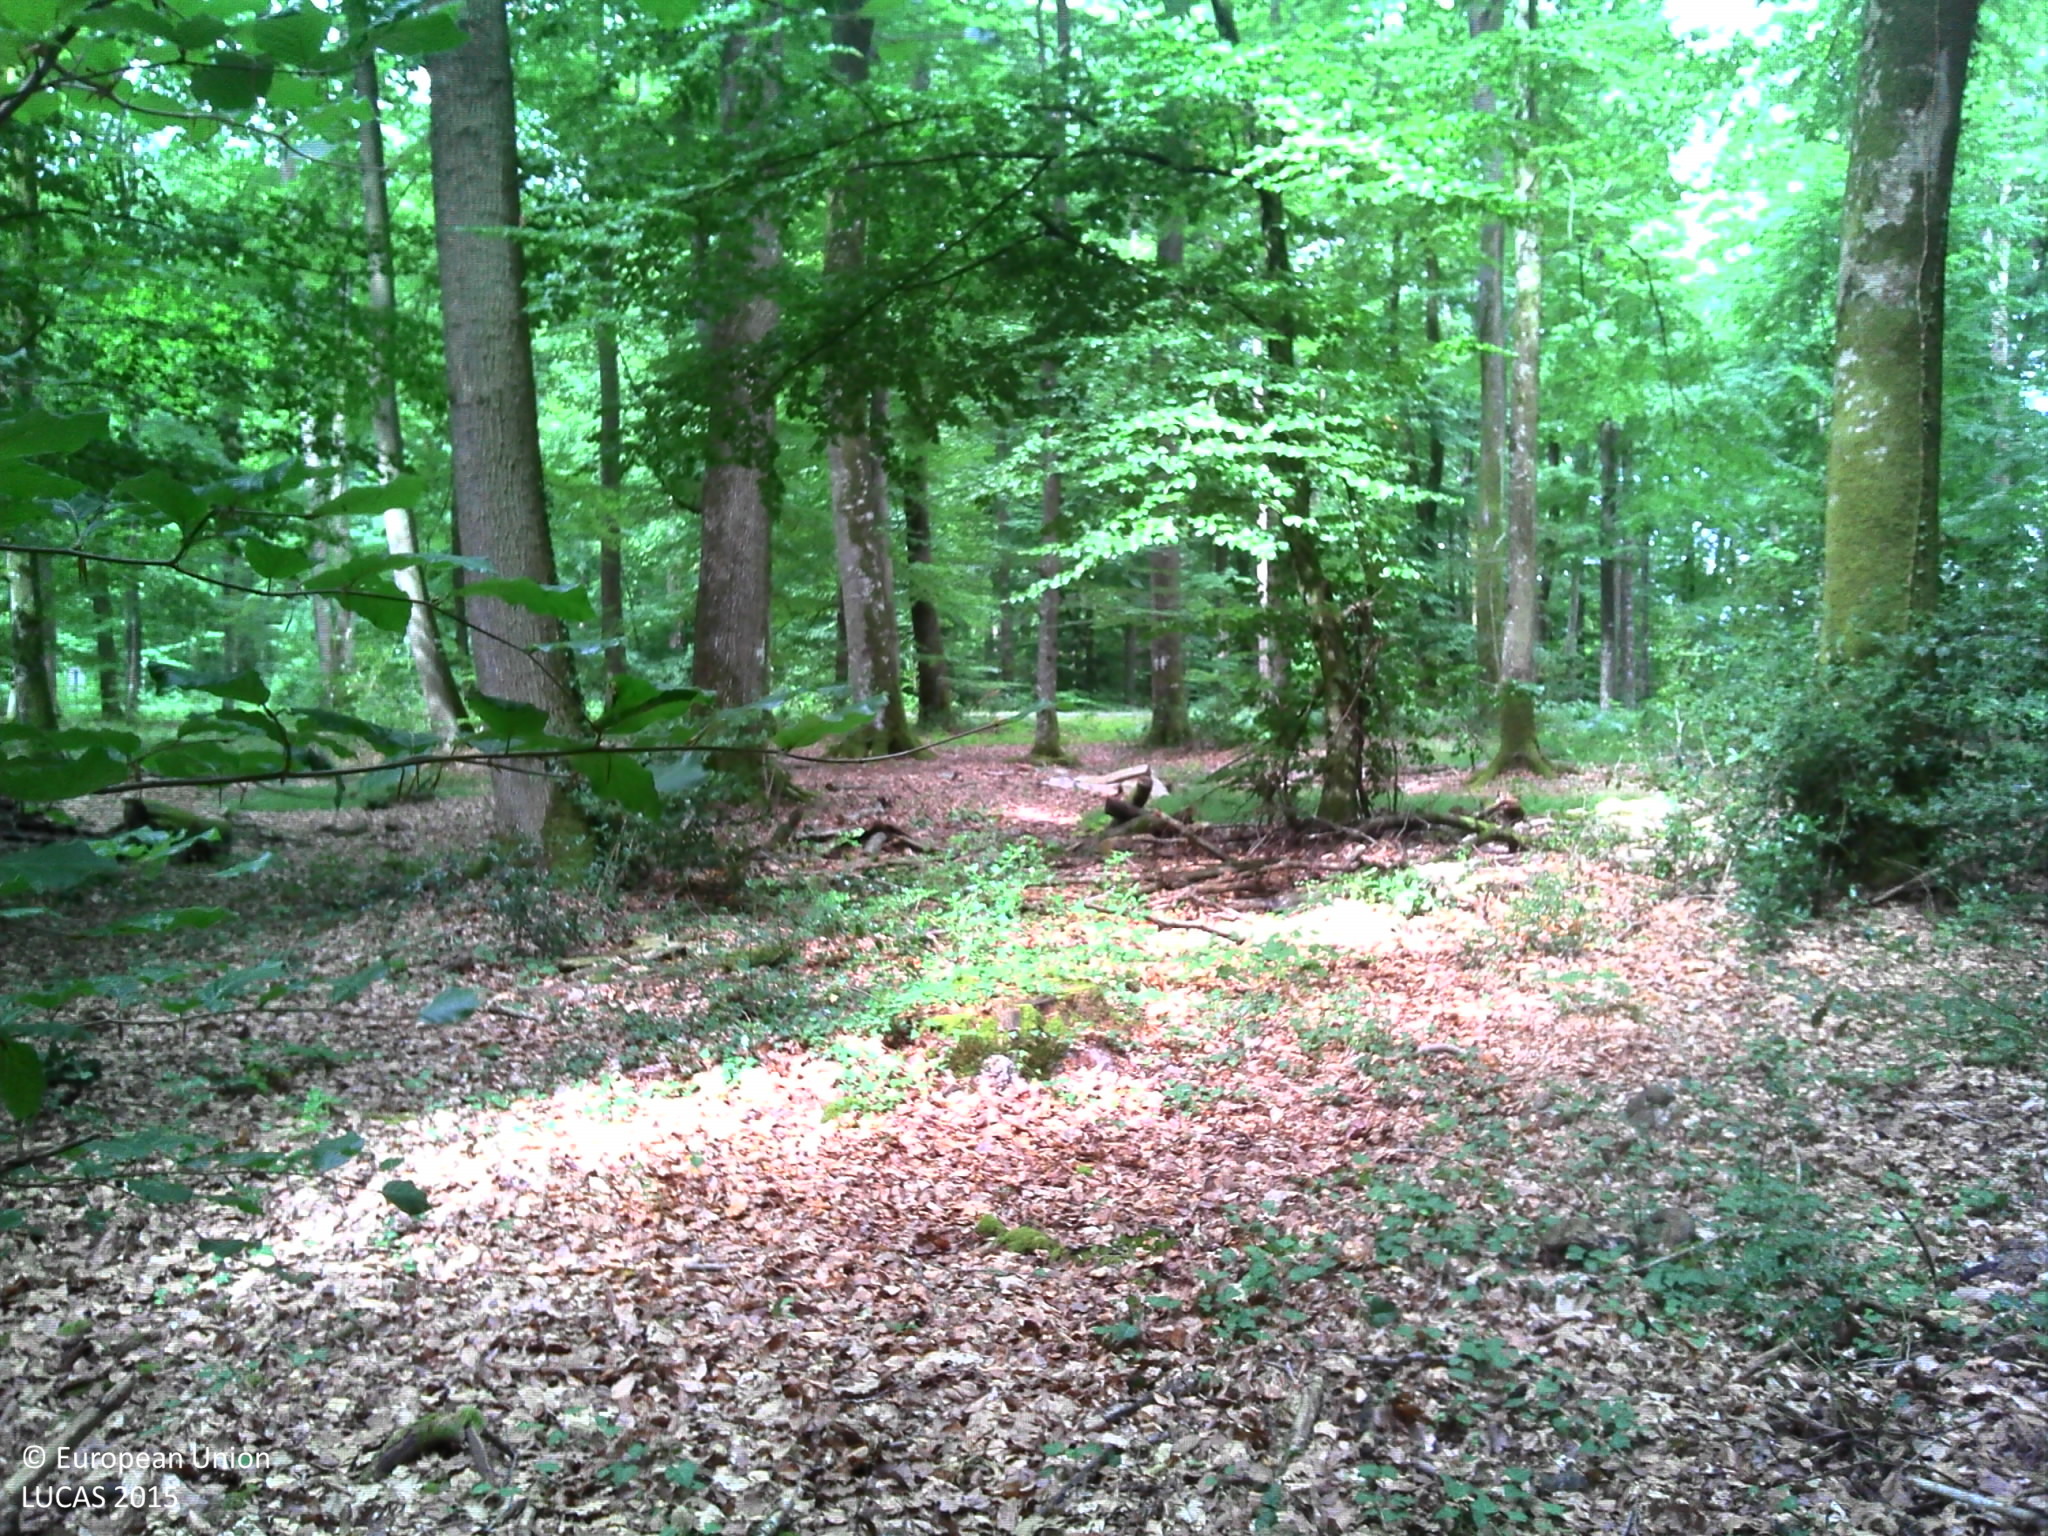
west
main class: Woodland
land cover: Broadleaved woodland
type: acidophilous oak and oak-birch forest
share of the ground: > 75 %
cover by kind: broadleaved forest trees 65 %, herbaceous plants 25 %, shrubs 10 %
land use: Forestry
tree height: > 5 m
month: July
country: FR
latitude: 47.8241
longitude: 0.4261
